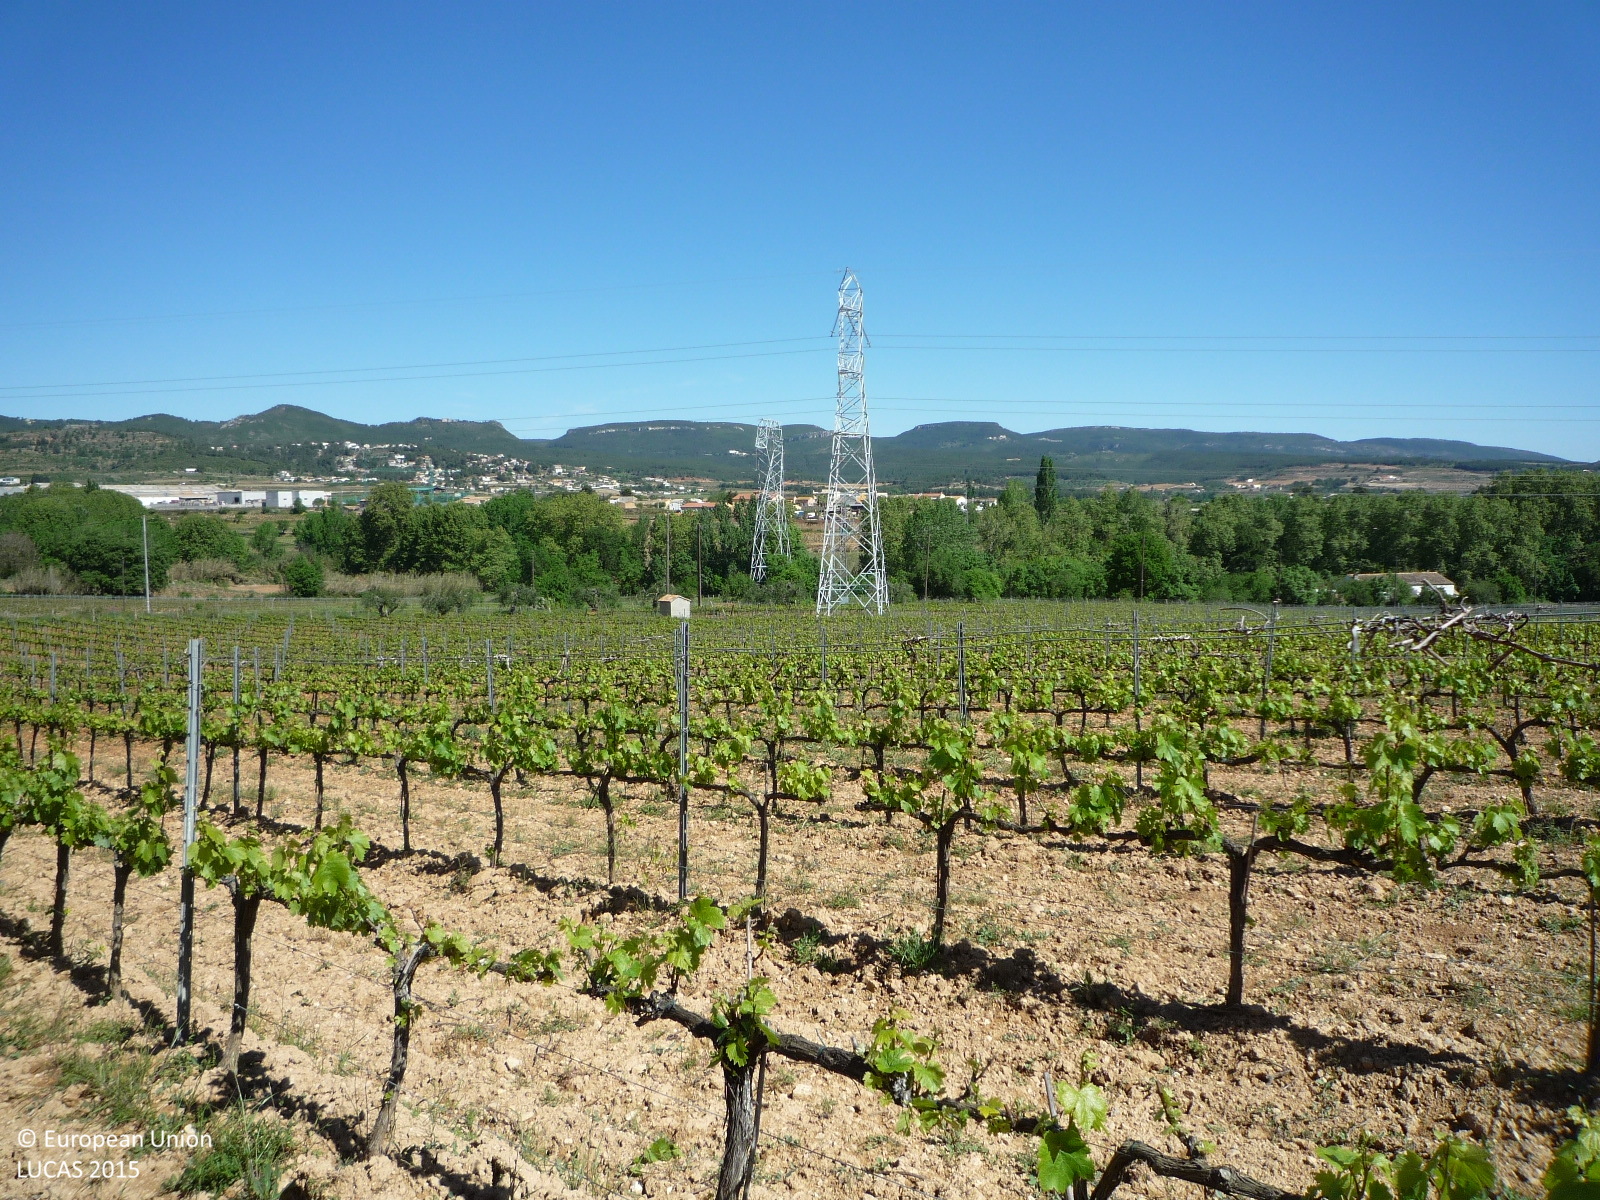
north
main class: Cropland
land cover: Vineyards
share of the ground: > 75 %
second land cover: Spontaneously vegetated surfaces
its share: 10 - 25 %
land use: Agriculture (excluding fallow land and kitchen gardens)
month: April
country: ES
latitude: 41.3776
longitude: 1.5872
